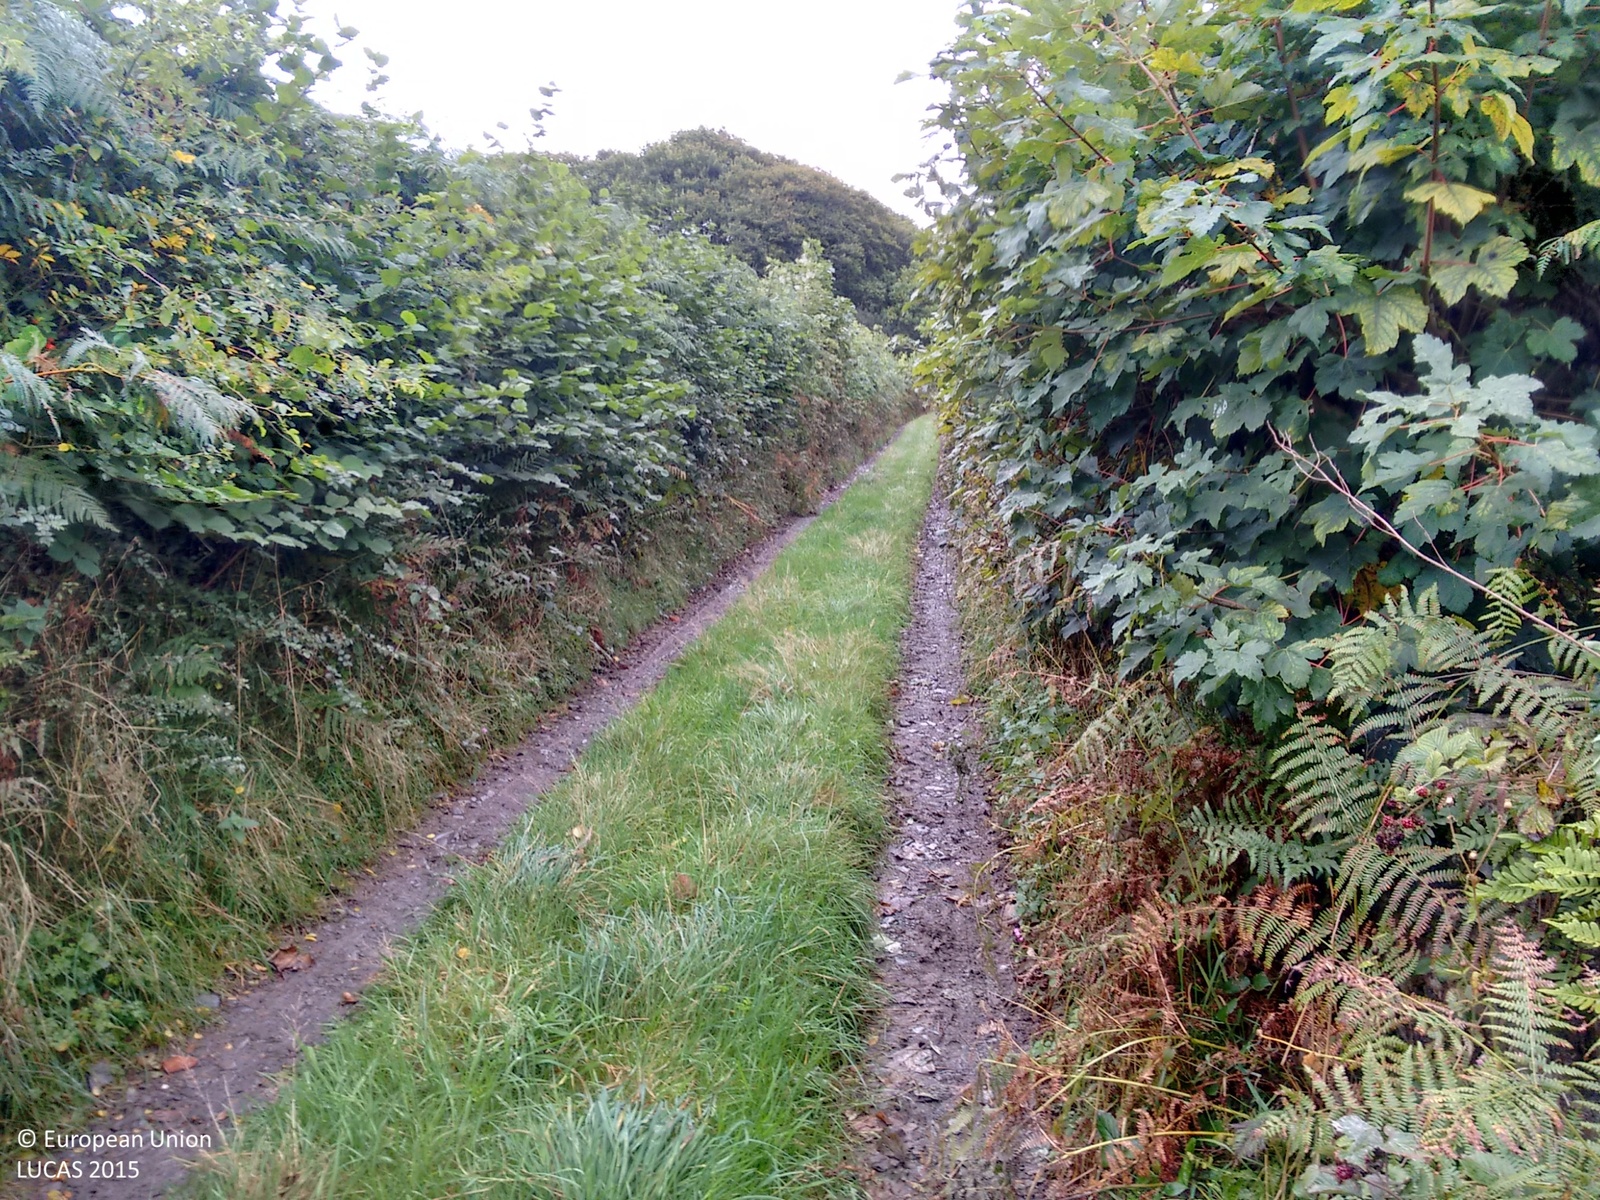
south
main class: Grassland
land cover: Grassland with sparse tree/shrub cover
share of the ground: > 75 %
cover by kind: herbaceous plants 95 %, broadleaved forest trees 5 %
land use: Agriculture (excluding fallow land and kitchen gardens)
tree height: > 5 m
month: October
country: GB
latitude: 52.5114
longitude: -3.9890
